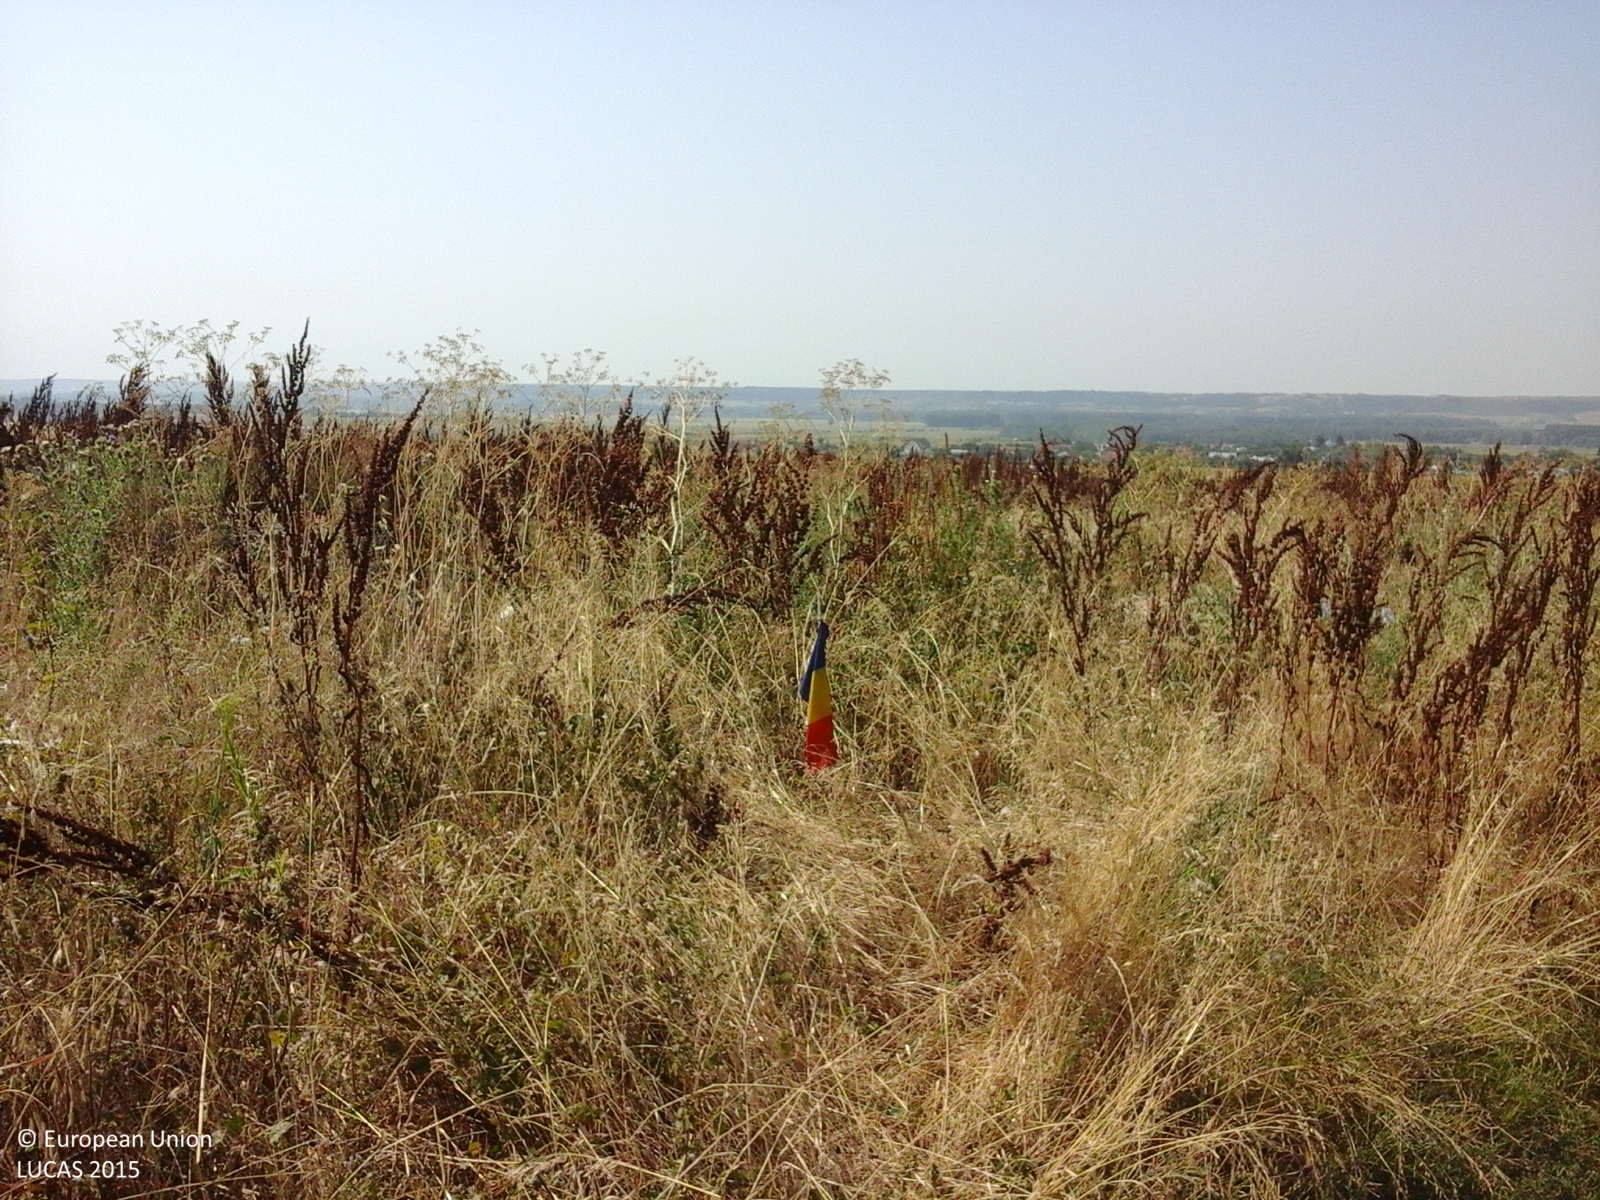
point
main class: Grassland
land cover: Spontaneously vegetated surfaces
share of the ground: > 75 %
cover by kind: herbaceous plants 100 %
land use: Fallow land
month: August
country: RO
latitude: 44.4853
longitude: 23.6480
